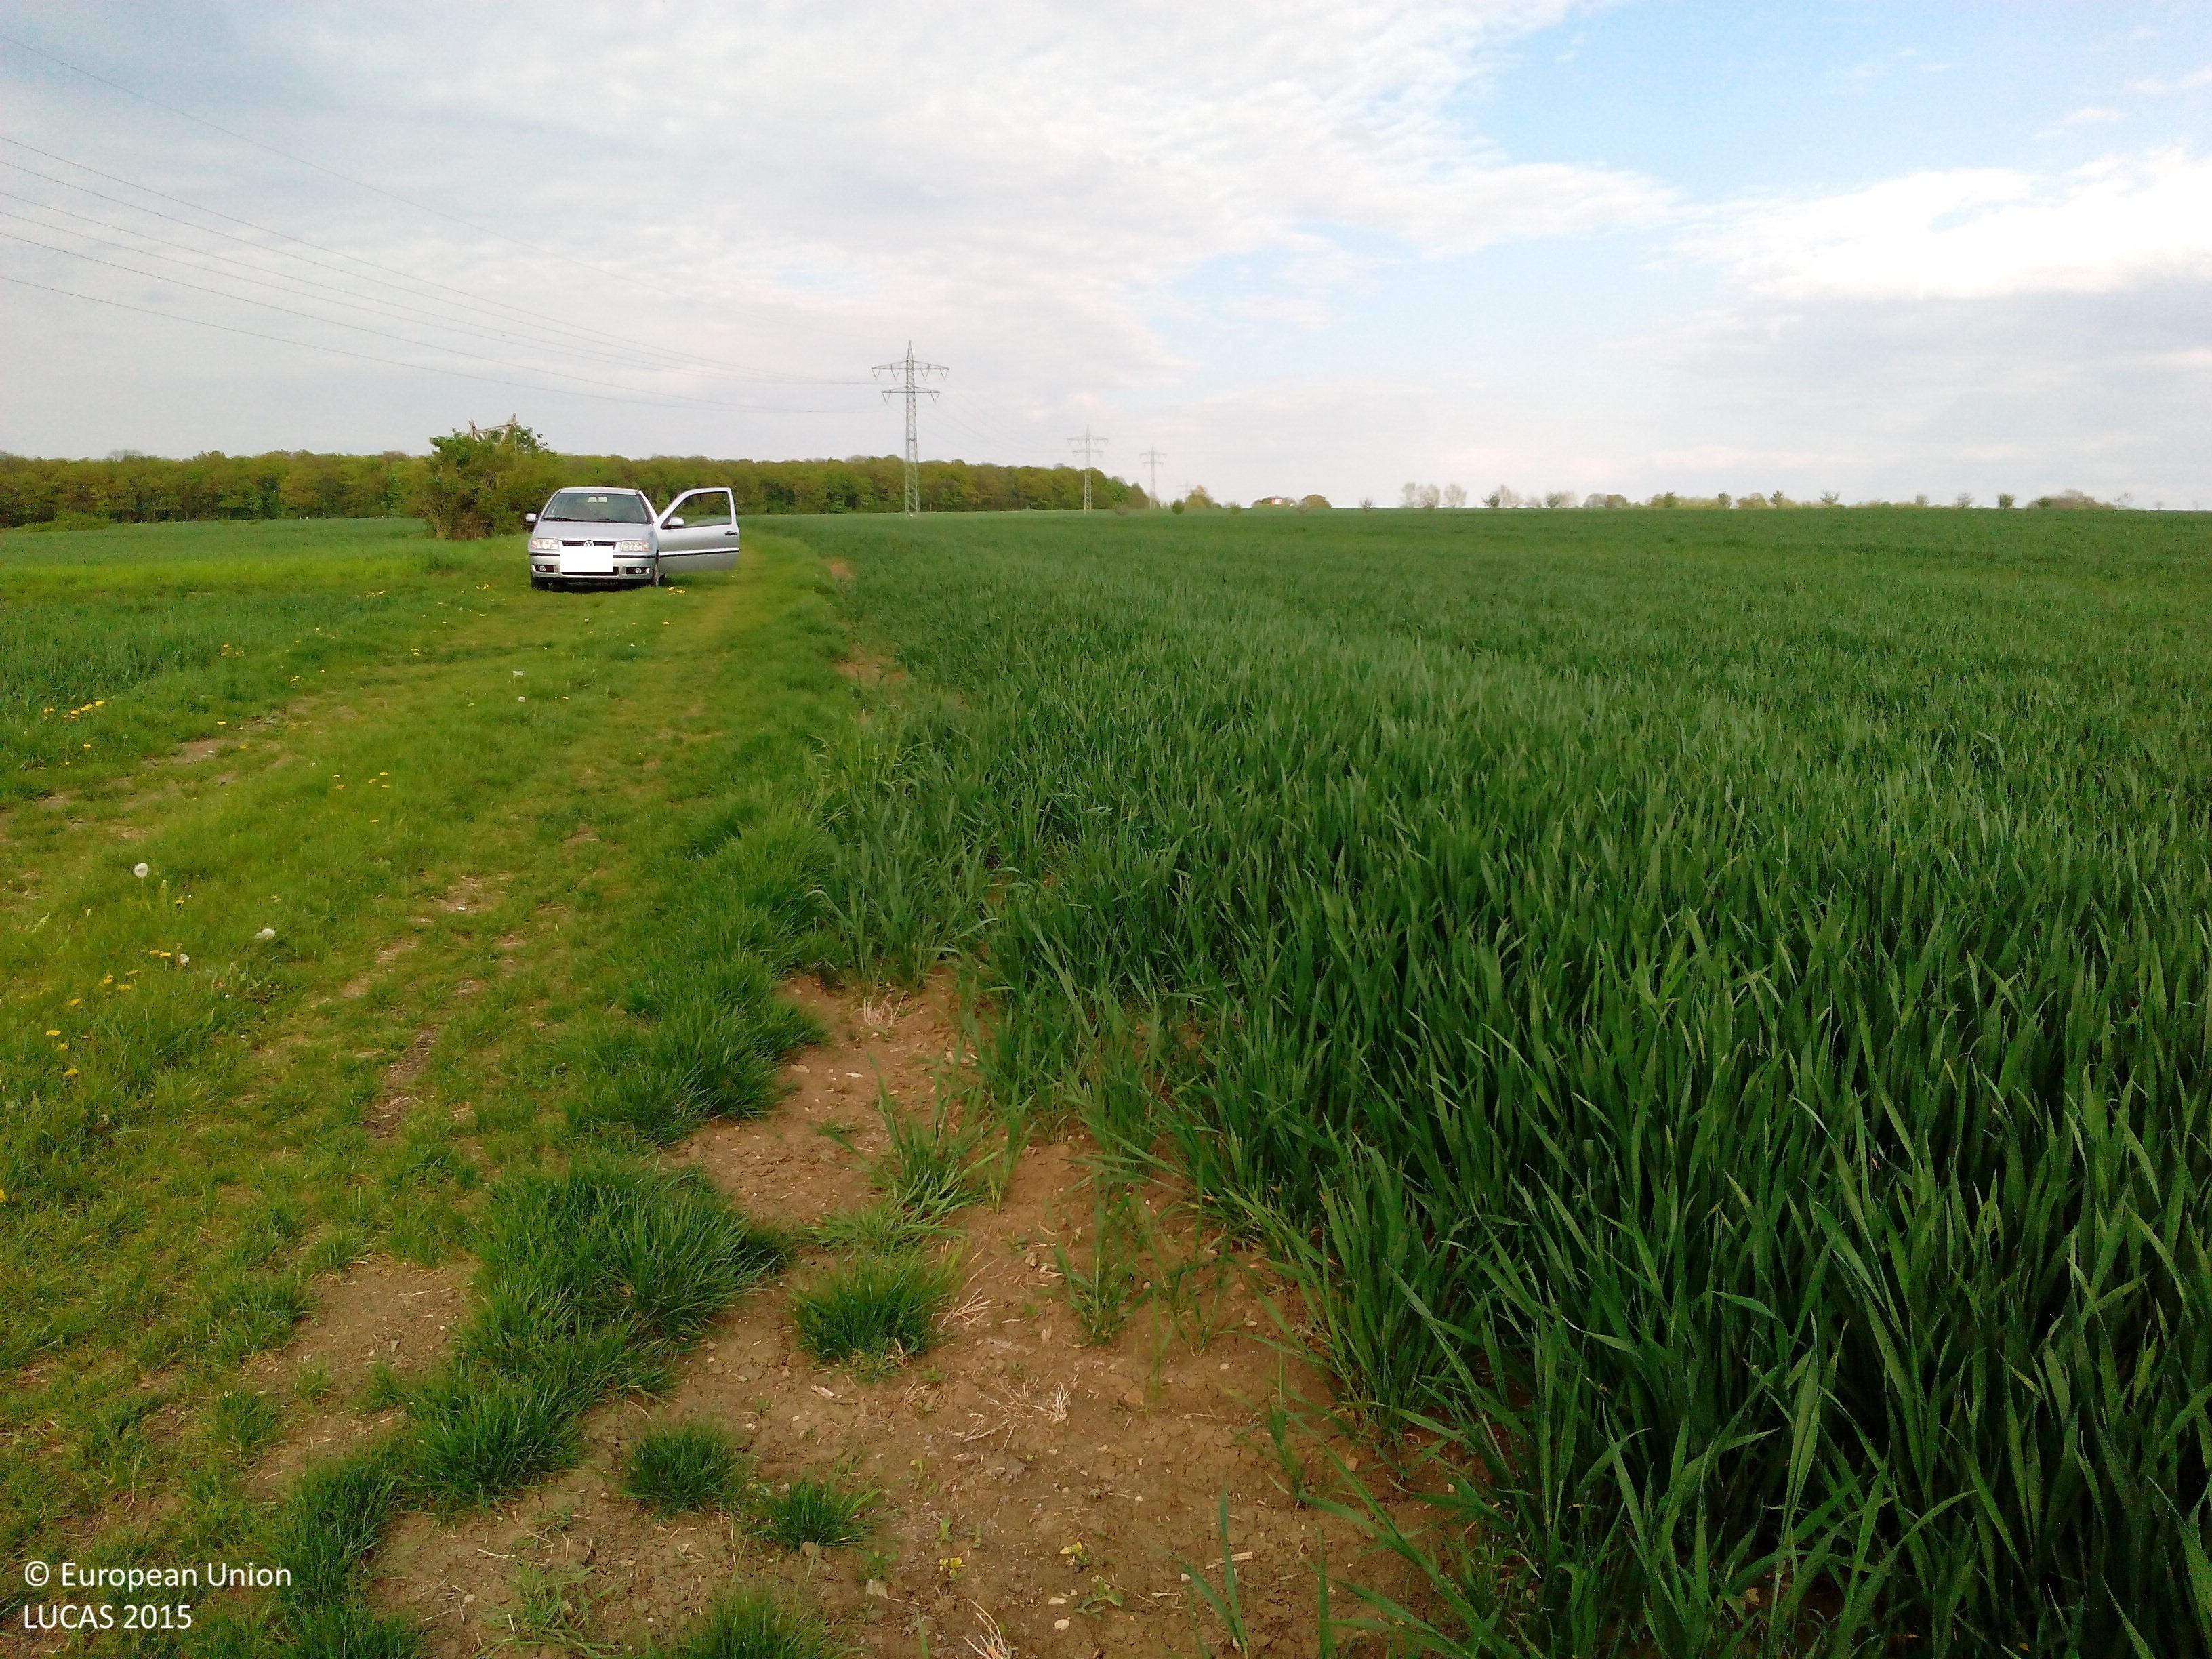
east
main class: Cropland
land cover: Common wheat
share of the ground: > 75 %
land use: Agriculture (excluding fallow land and kitchen gardens)
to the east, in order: Common wheat; Electric lines; Common wheat
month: May
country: DE
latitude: 50.9650
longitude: 11.5517
